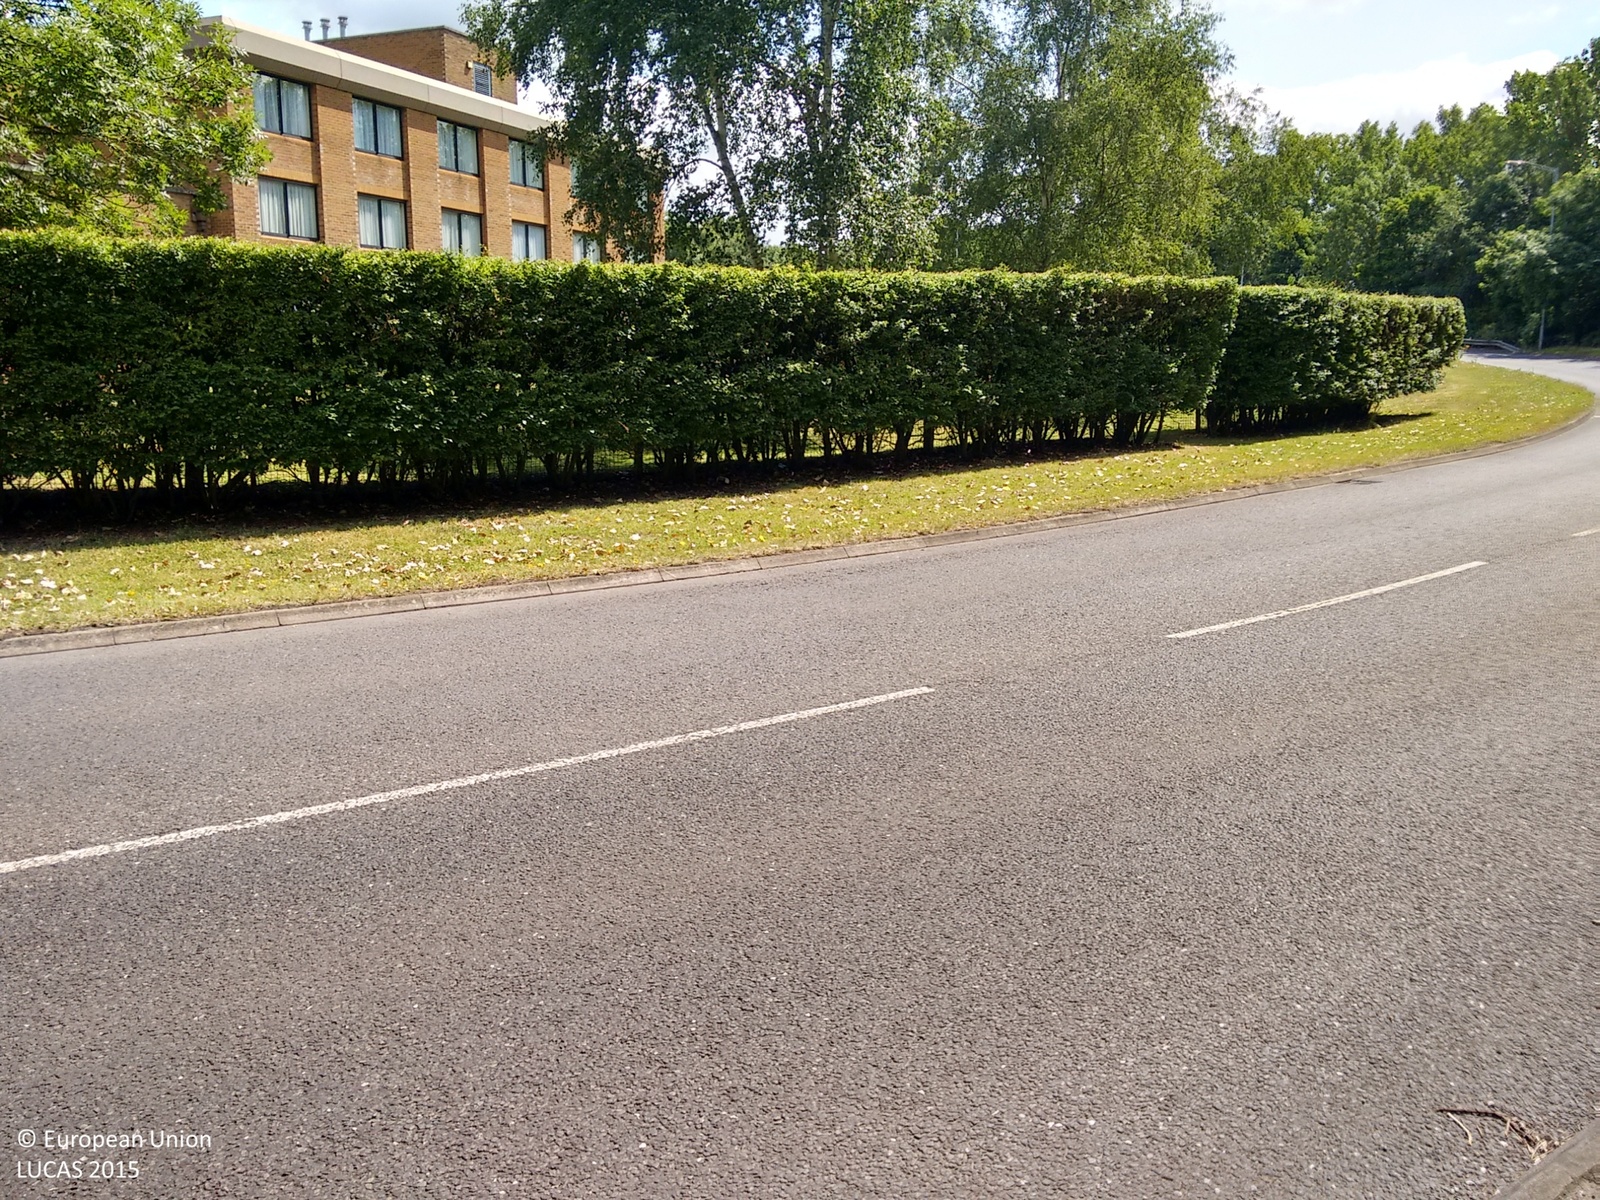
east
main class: Woodland
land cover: Broadleaved woodland
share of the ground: > 75 %
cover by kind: herbaceous plants 85 %, broadleaved forest trees 15 %
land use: Sport
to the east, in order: Broadleaved woodland; Fences; Abandoned hedges; Paved roads, cycling and walking lanes; Lines of trees; Grassland without tree/shrub cover; Artificial constructions in urban areas; Grassland without tree/shrub cover; Broadleaved woodland; Paved roads, cycling and walking lanes
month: July
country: GB
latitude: 52.5637
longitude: -0.2884
